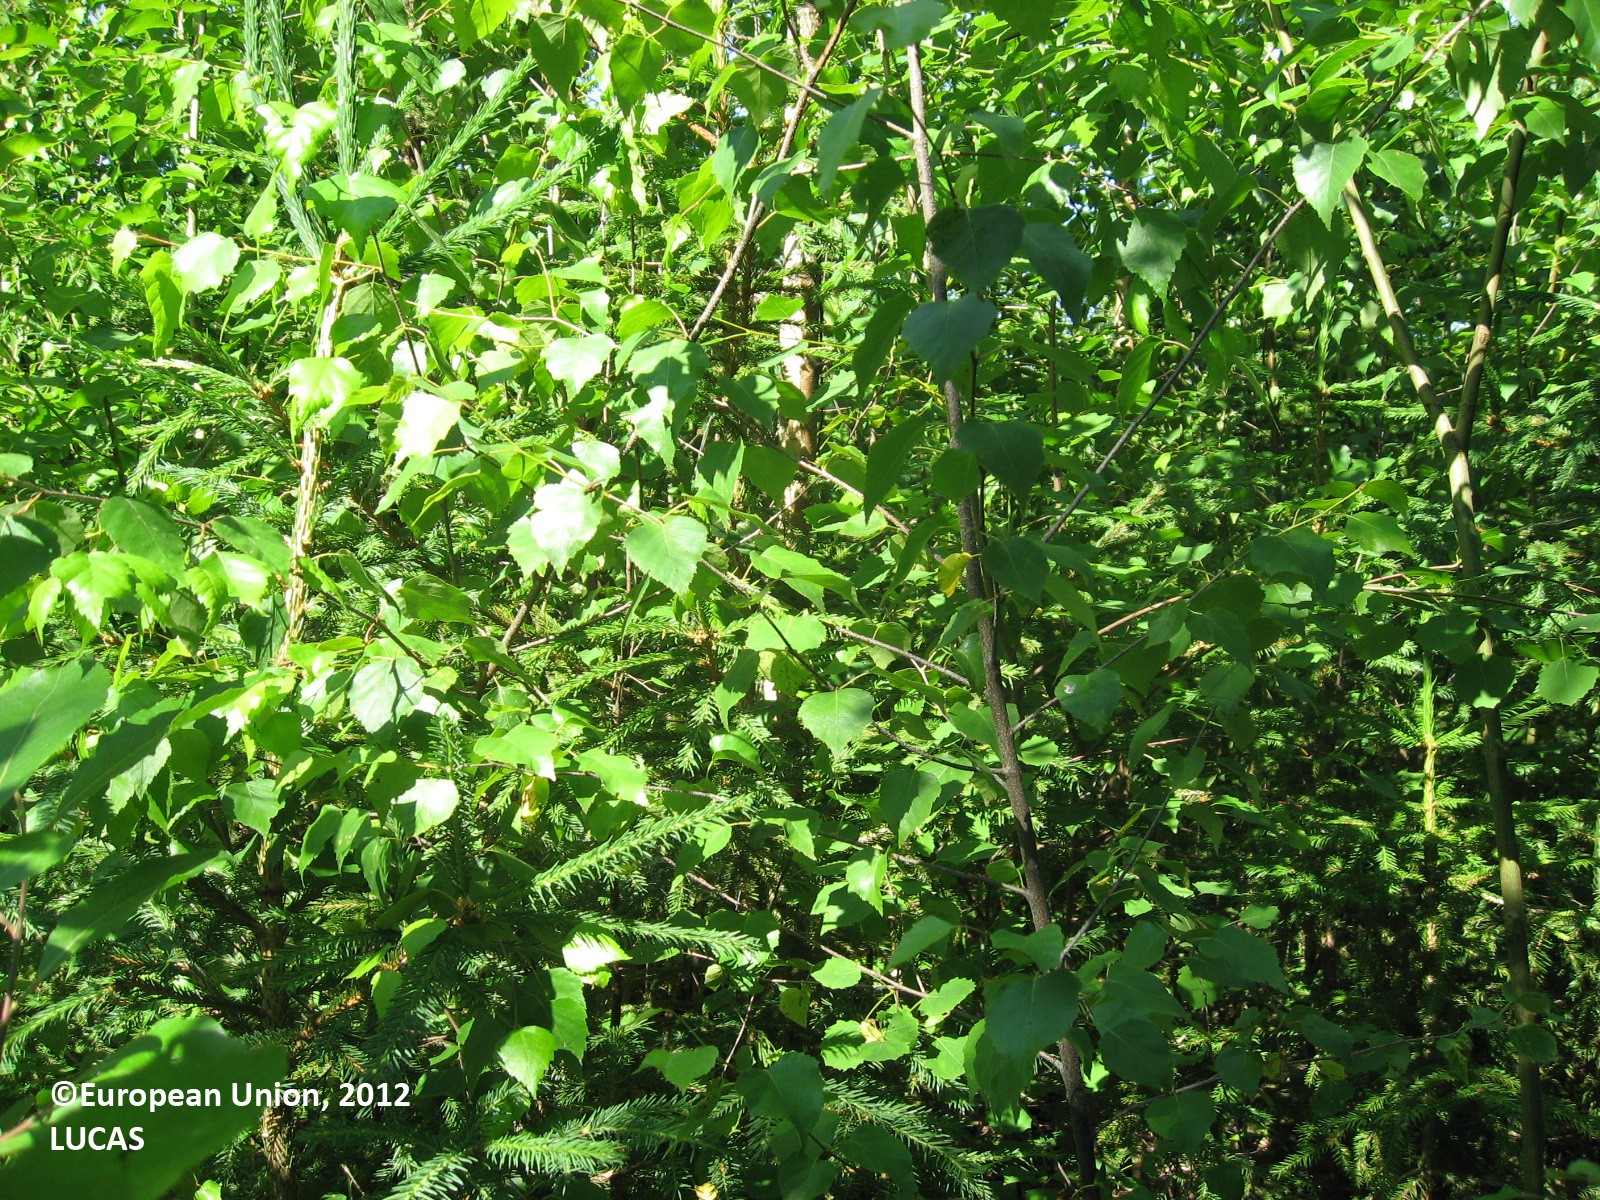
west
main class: Woodland
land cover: Spruce dominated mixed woodland
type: boreal forest
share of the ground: 50 - 75 %
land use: Forestry
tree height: > 5 m
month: July
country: FI
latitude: 60.9533
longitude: 26.4925
